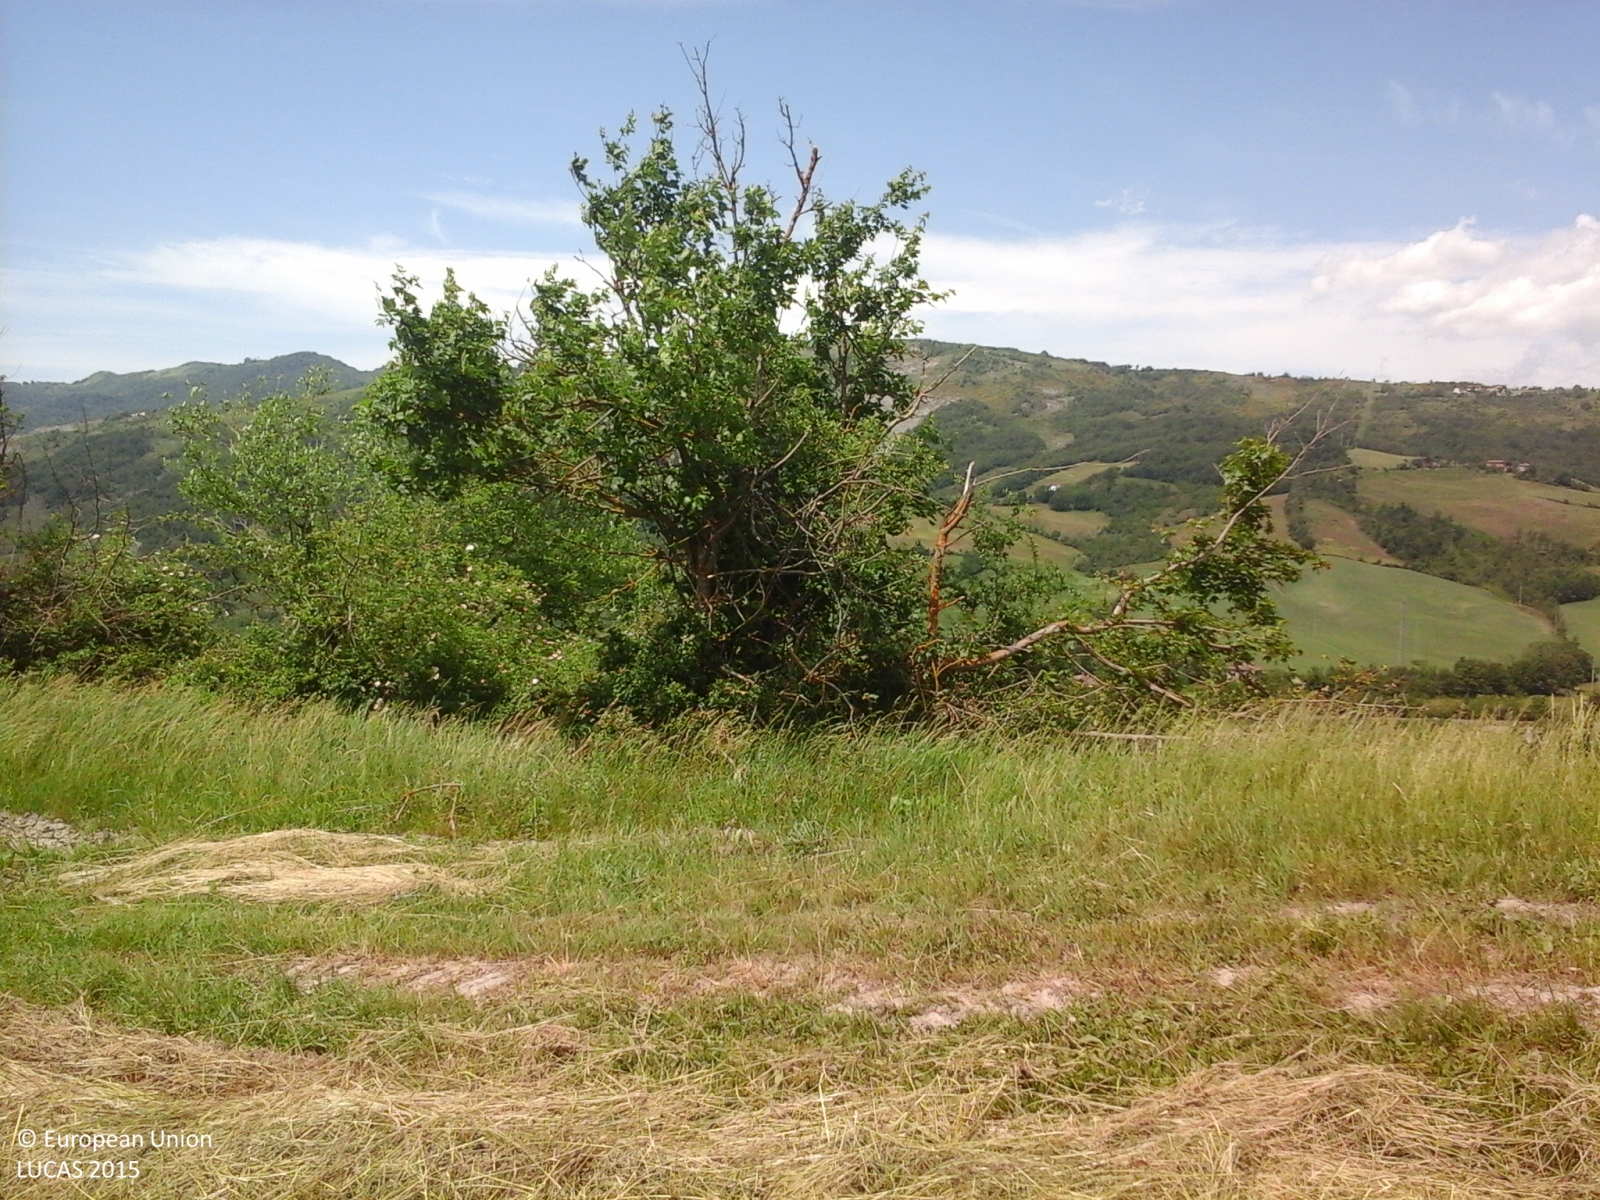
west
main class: Grassland
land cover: Grassland without tree/shrub cover
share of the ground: > 75 %
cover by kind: herbaceous plants 100 %
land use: Agriculture (excluding fallow land and kitchen gardens)
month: May
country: IT
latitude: 44.2544
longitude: 11.1121
